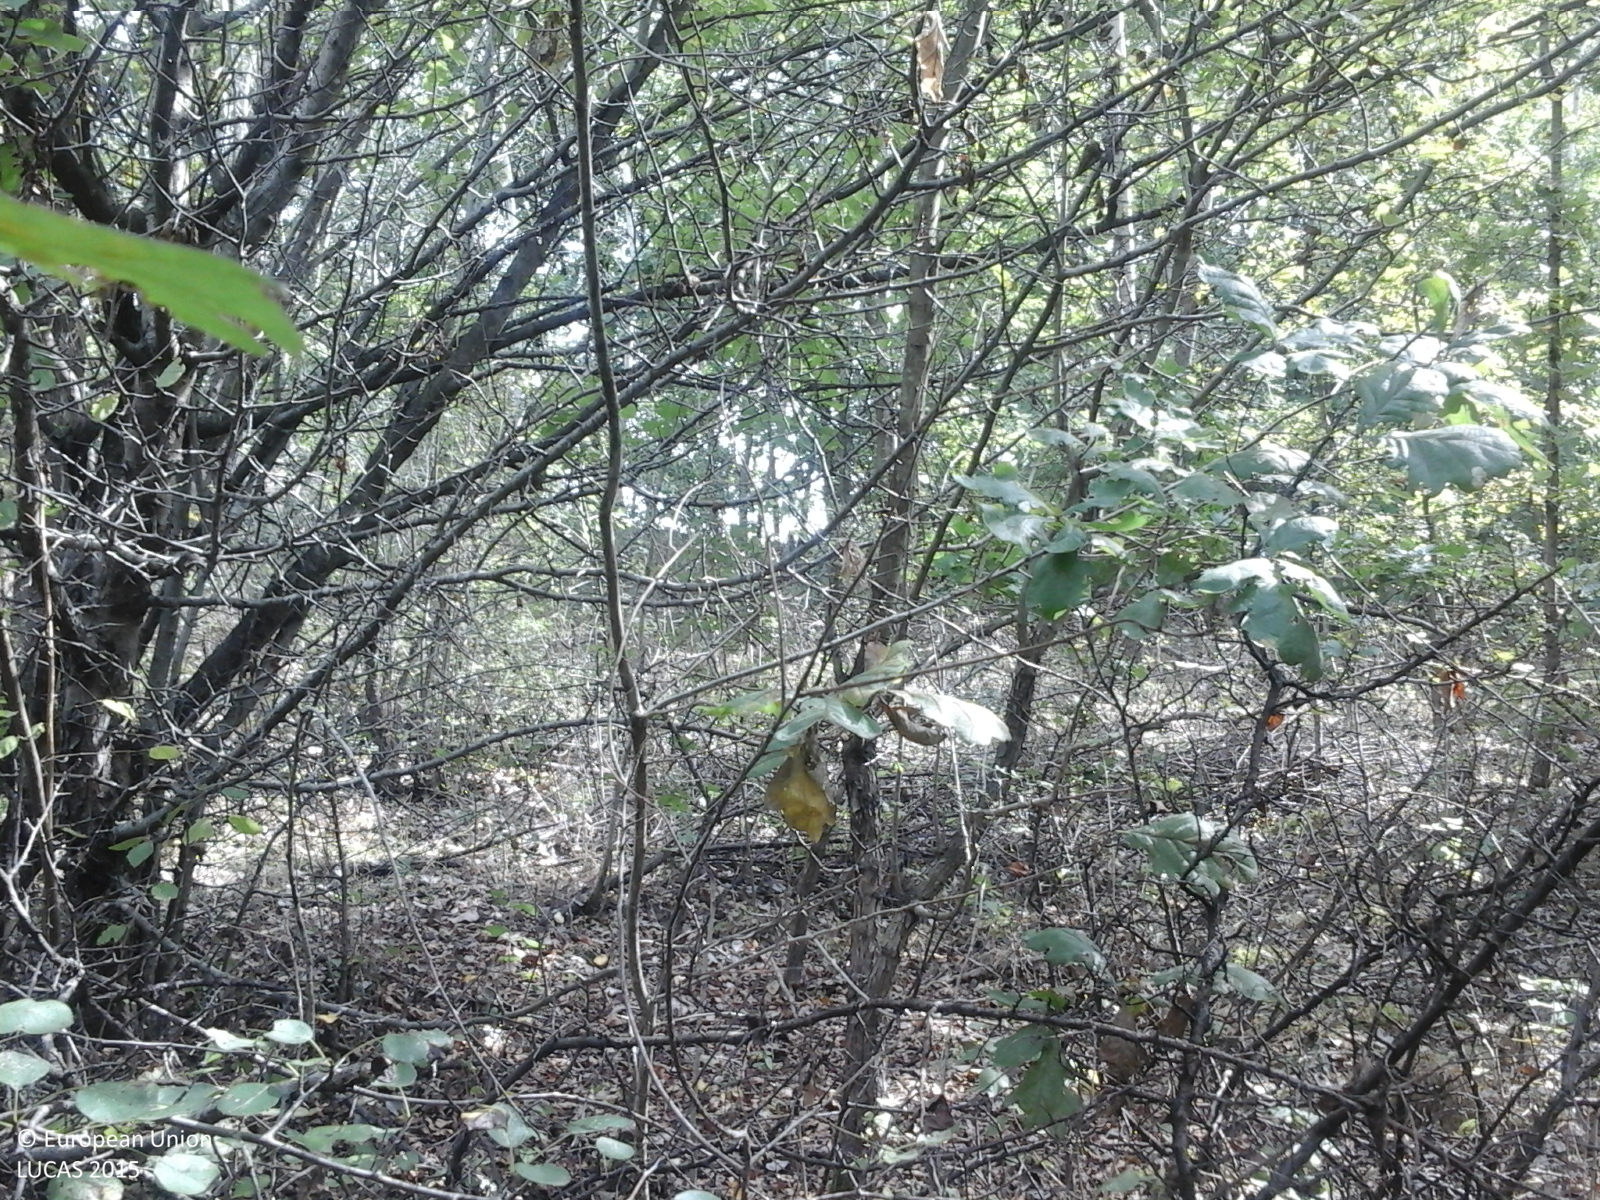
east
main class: Woodland
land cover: Broadleaved woodland
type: acidophilous oak and oak-birch forest
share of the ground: > 75 %
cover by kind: broadleaved forest trees 100 %
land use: Forestry
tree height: > 5 m
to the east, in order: Broadleaved woodland; Tracks; Broadleaved woodland; Lines of trees; Grassland with sparse tree/shrub cover; Spontaneously vegetated surfaces
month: September
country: RO
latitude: 47.3475
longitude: 23.5356
